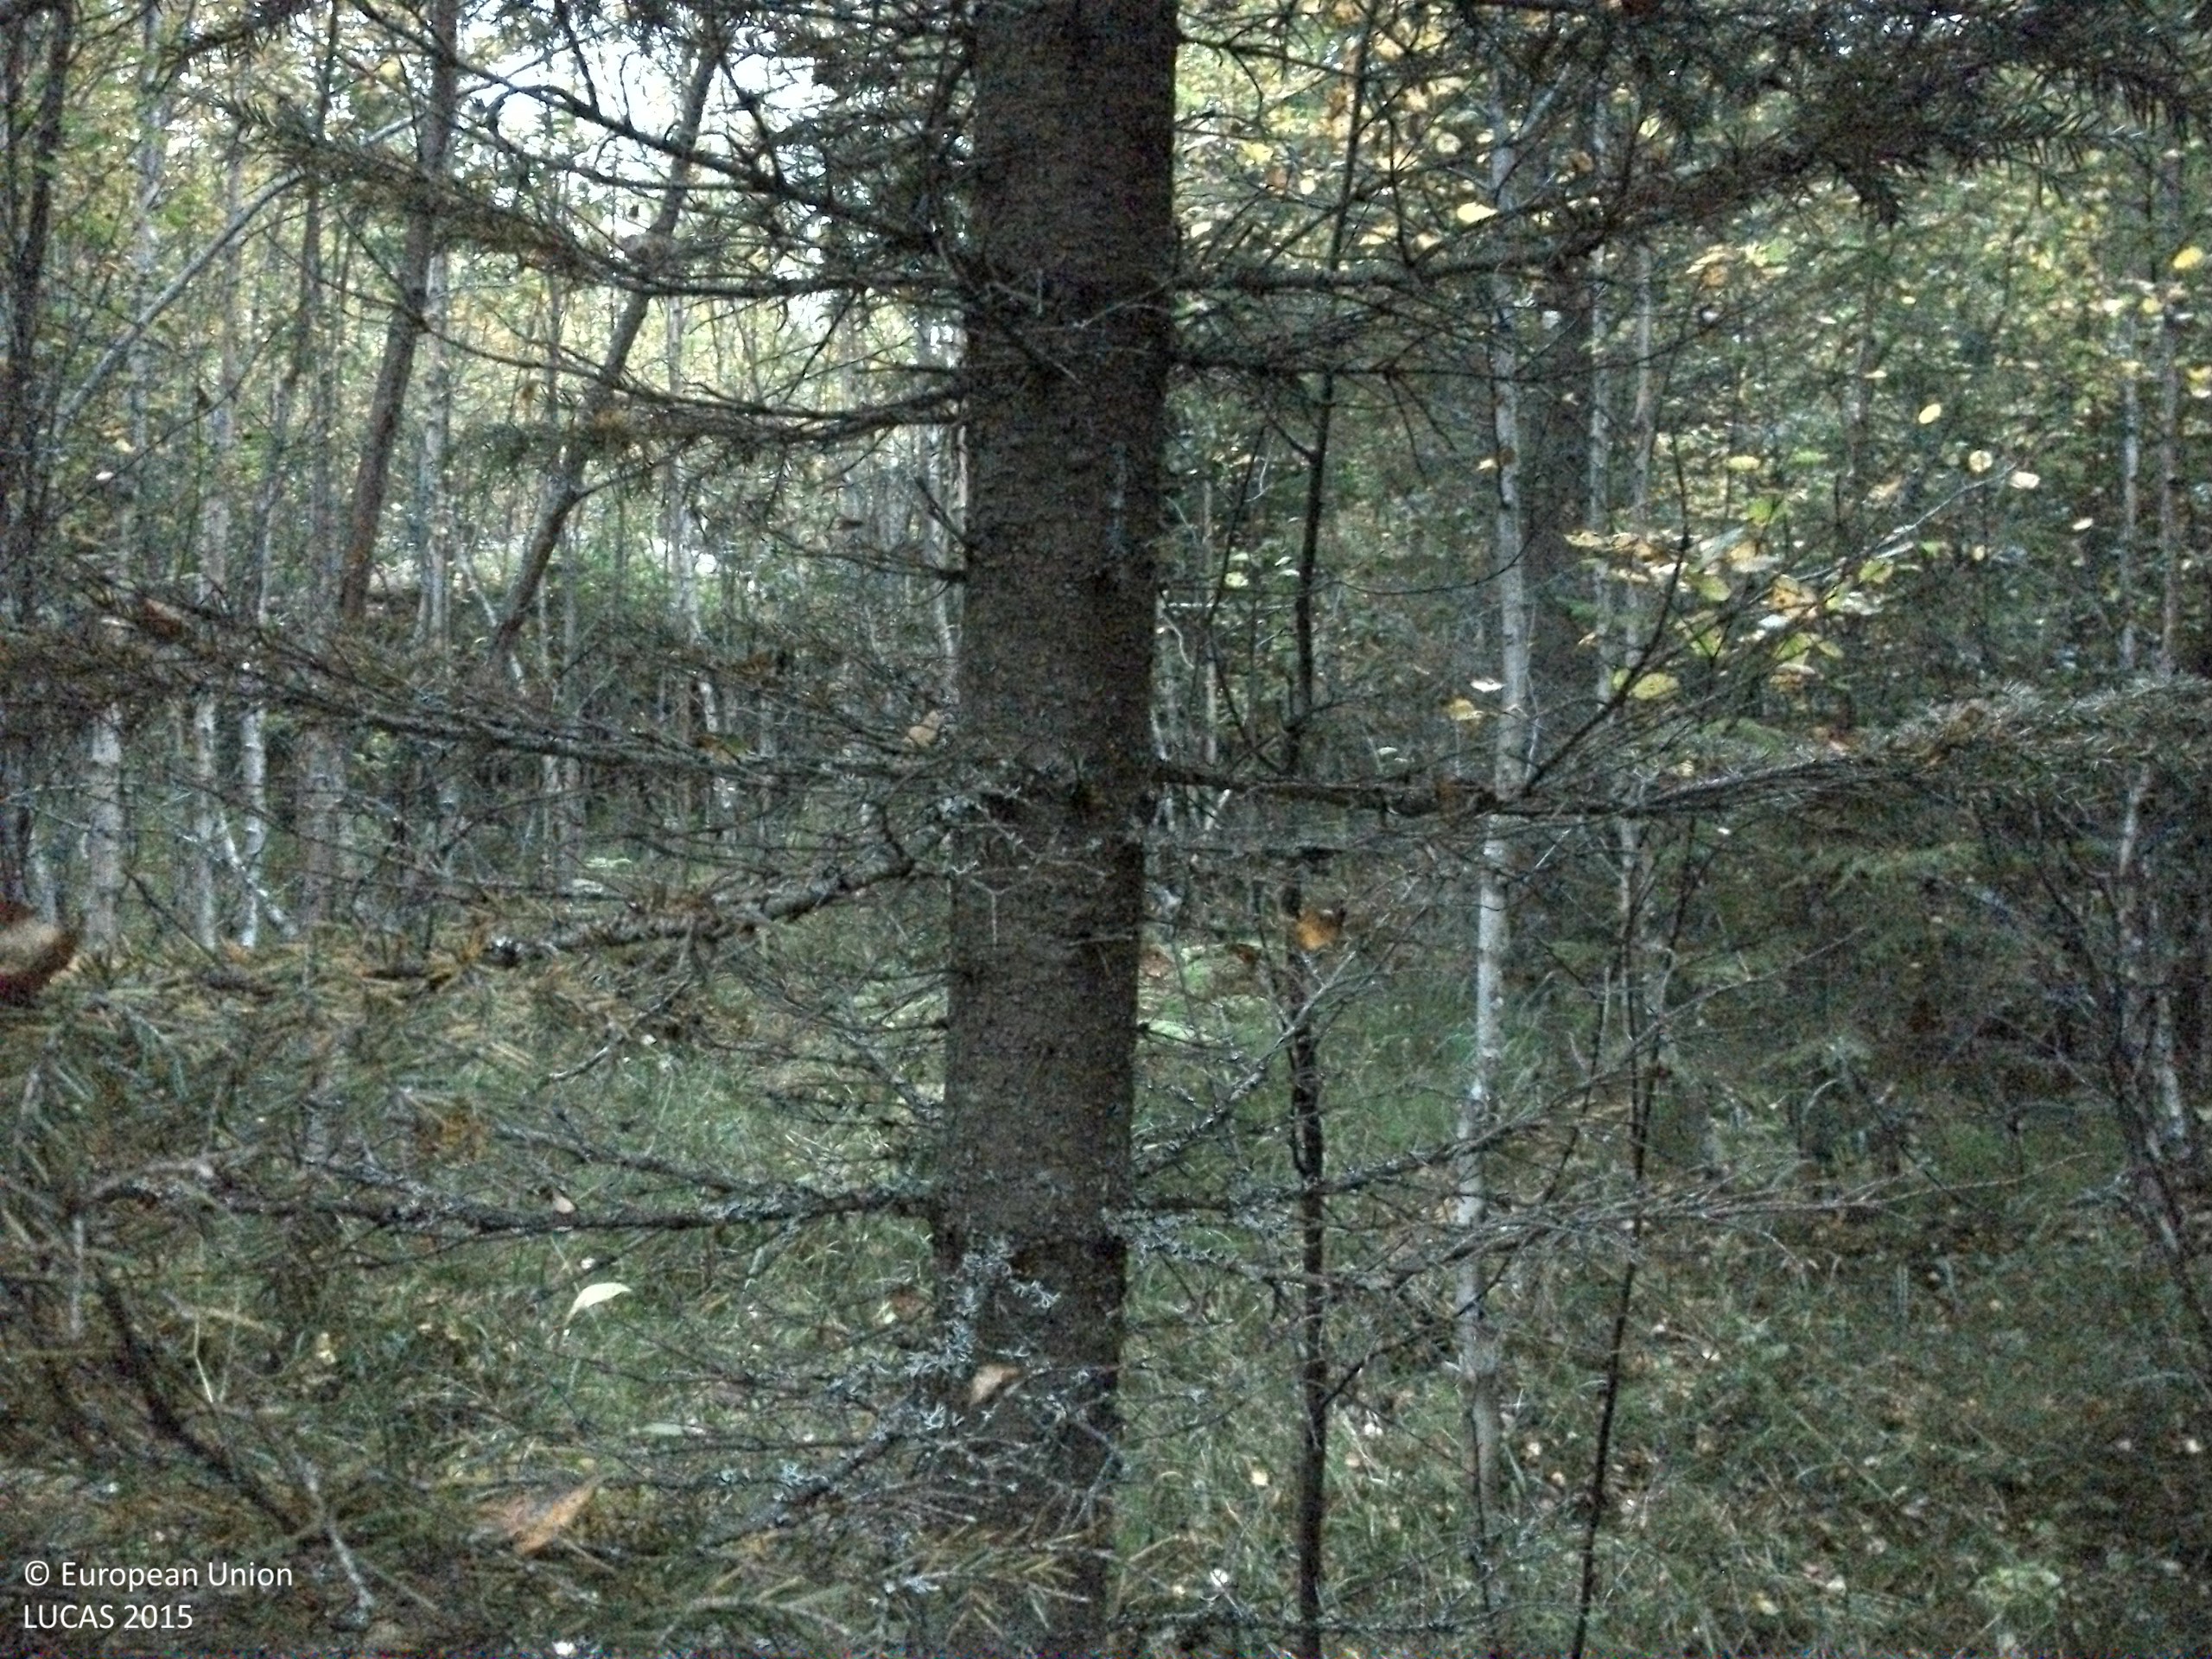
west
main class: Woodland
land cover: Spruce dominated mixed woodland
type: boreal forest
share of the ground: > 75 %
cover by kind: coniferous forest trees 50 %, broadleaved forest trees 25 %, shrubs 10 %, herbaceous plants 10 %, lichens and mosses 5 %
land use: Forestry
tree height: > 5 m
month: September
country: SE
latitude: 63.6161
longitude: 15.9641
